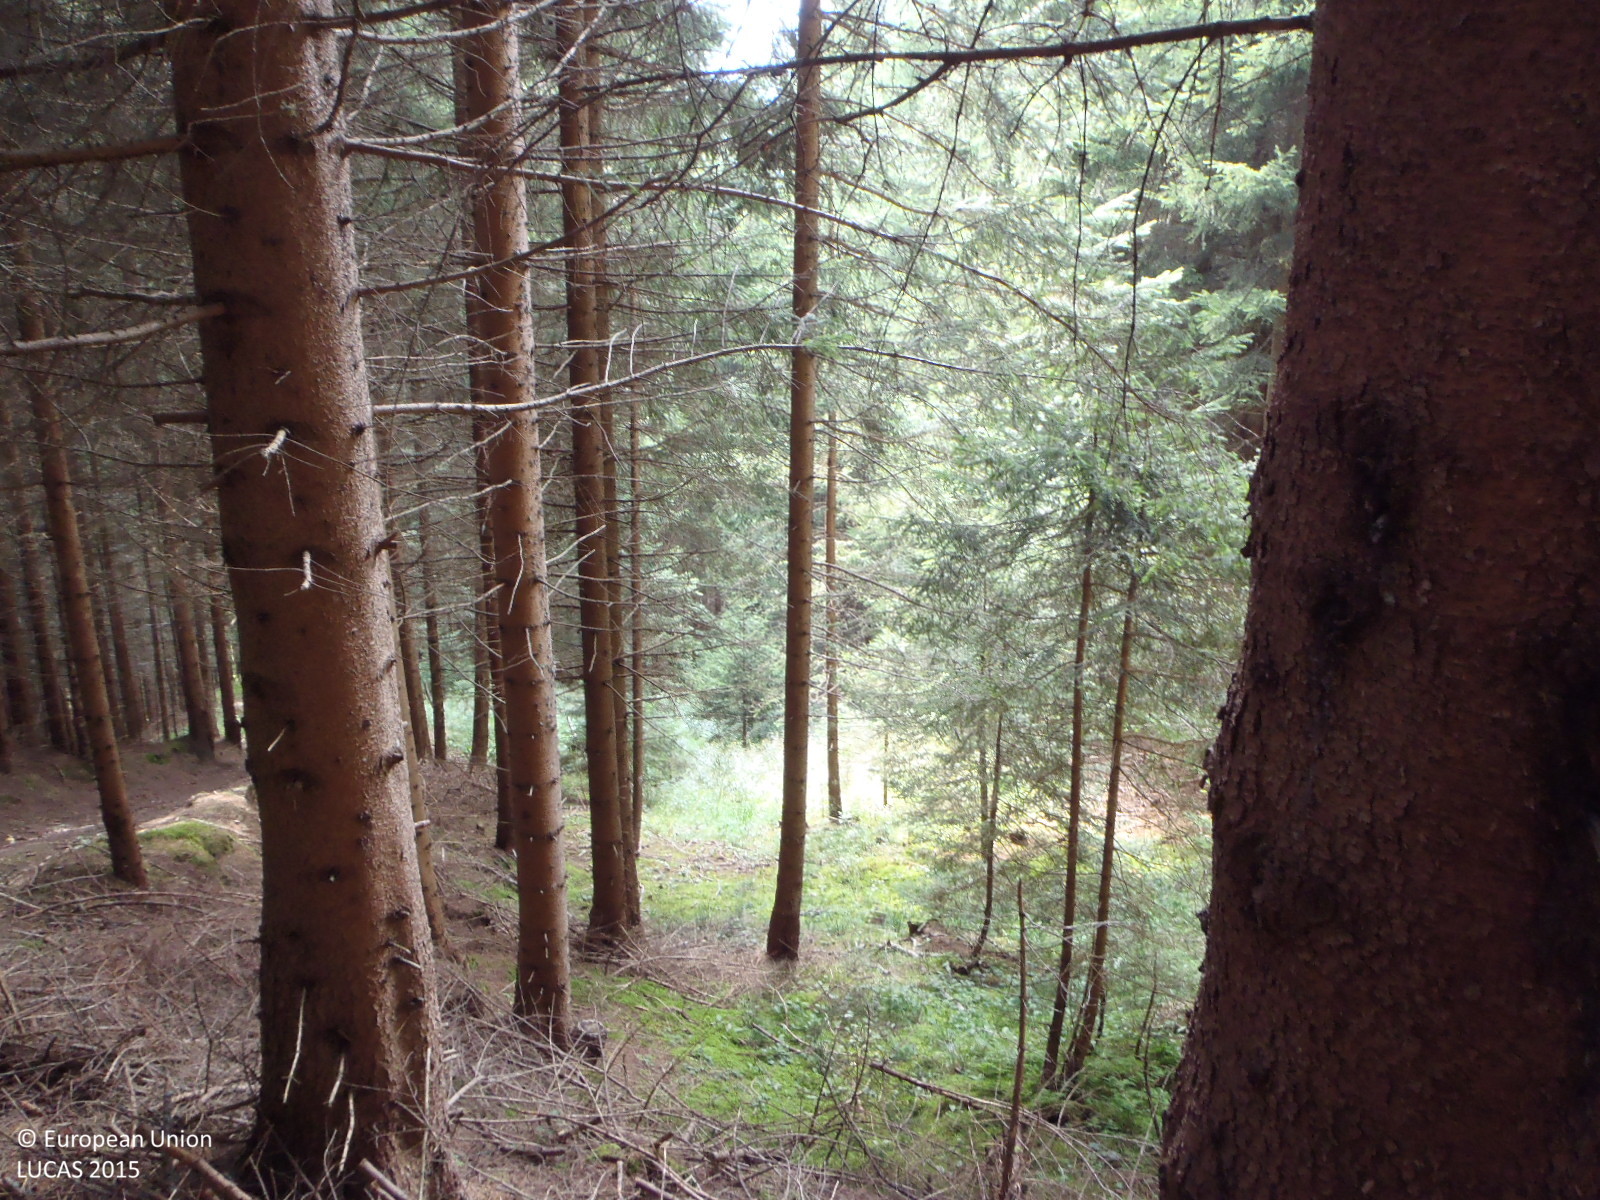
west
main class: Woodland
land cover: Spruce dominated coniferous woodland
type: alpine coniferous forest
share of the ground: > 75 %
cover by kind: coniferous forest trees 90 %, lichens and mosses 5 %, unconsolidated bare surface 5 %
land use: Forestry
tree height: > 5 m
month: August
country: AT
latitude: 47.1164
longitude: 13.7014
